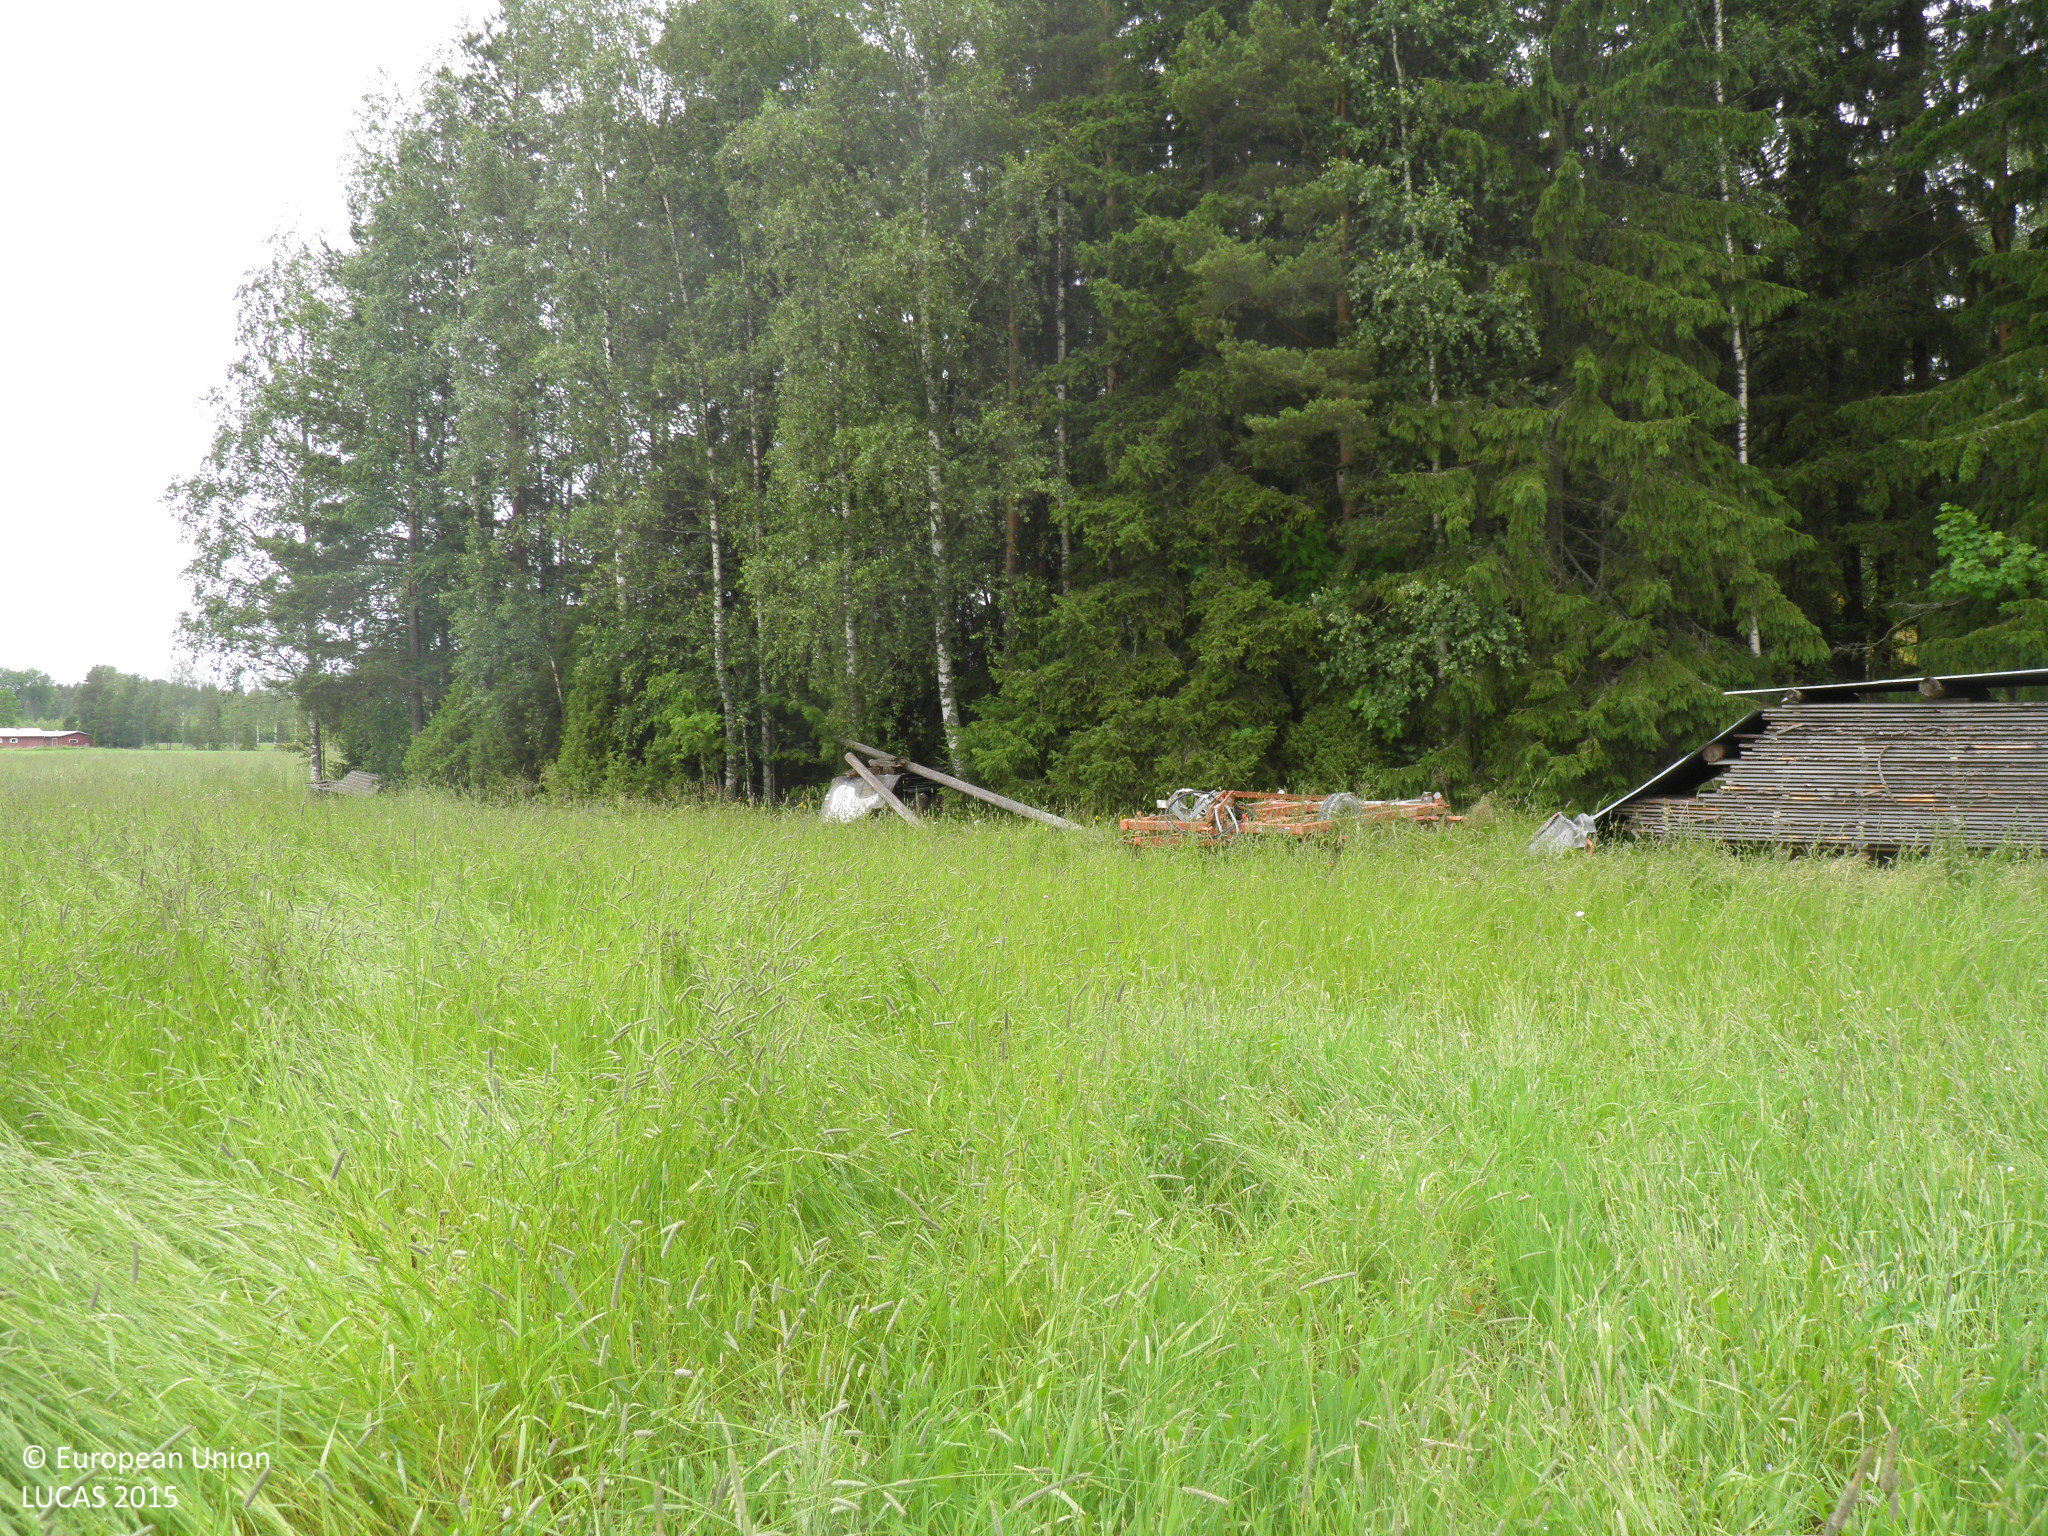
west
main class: Cropland
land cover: Temporary grasslands
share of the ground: > 75 %
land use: Agriculture (excluding fallow land and kitchen gardens)
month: July
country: FI
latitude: 60.6844
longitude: 22.8732
